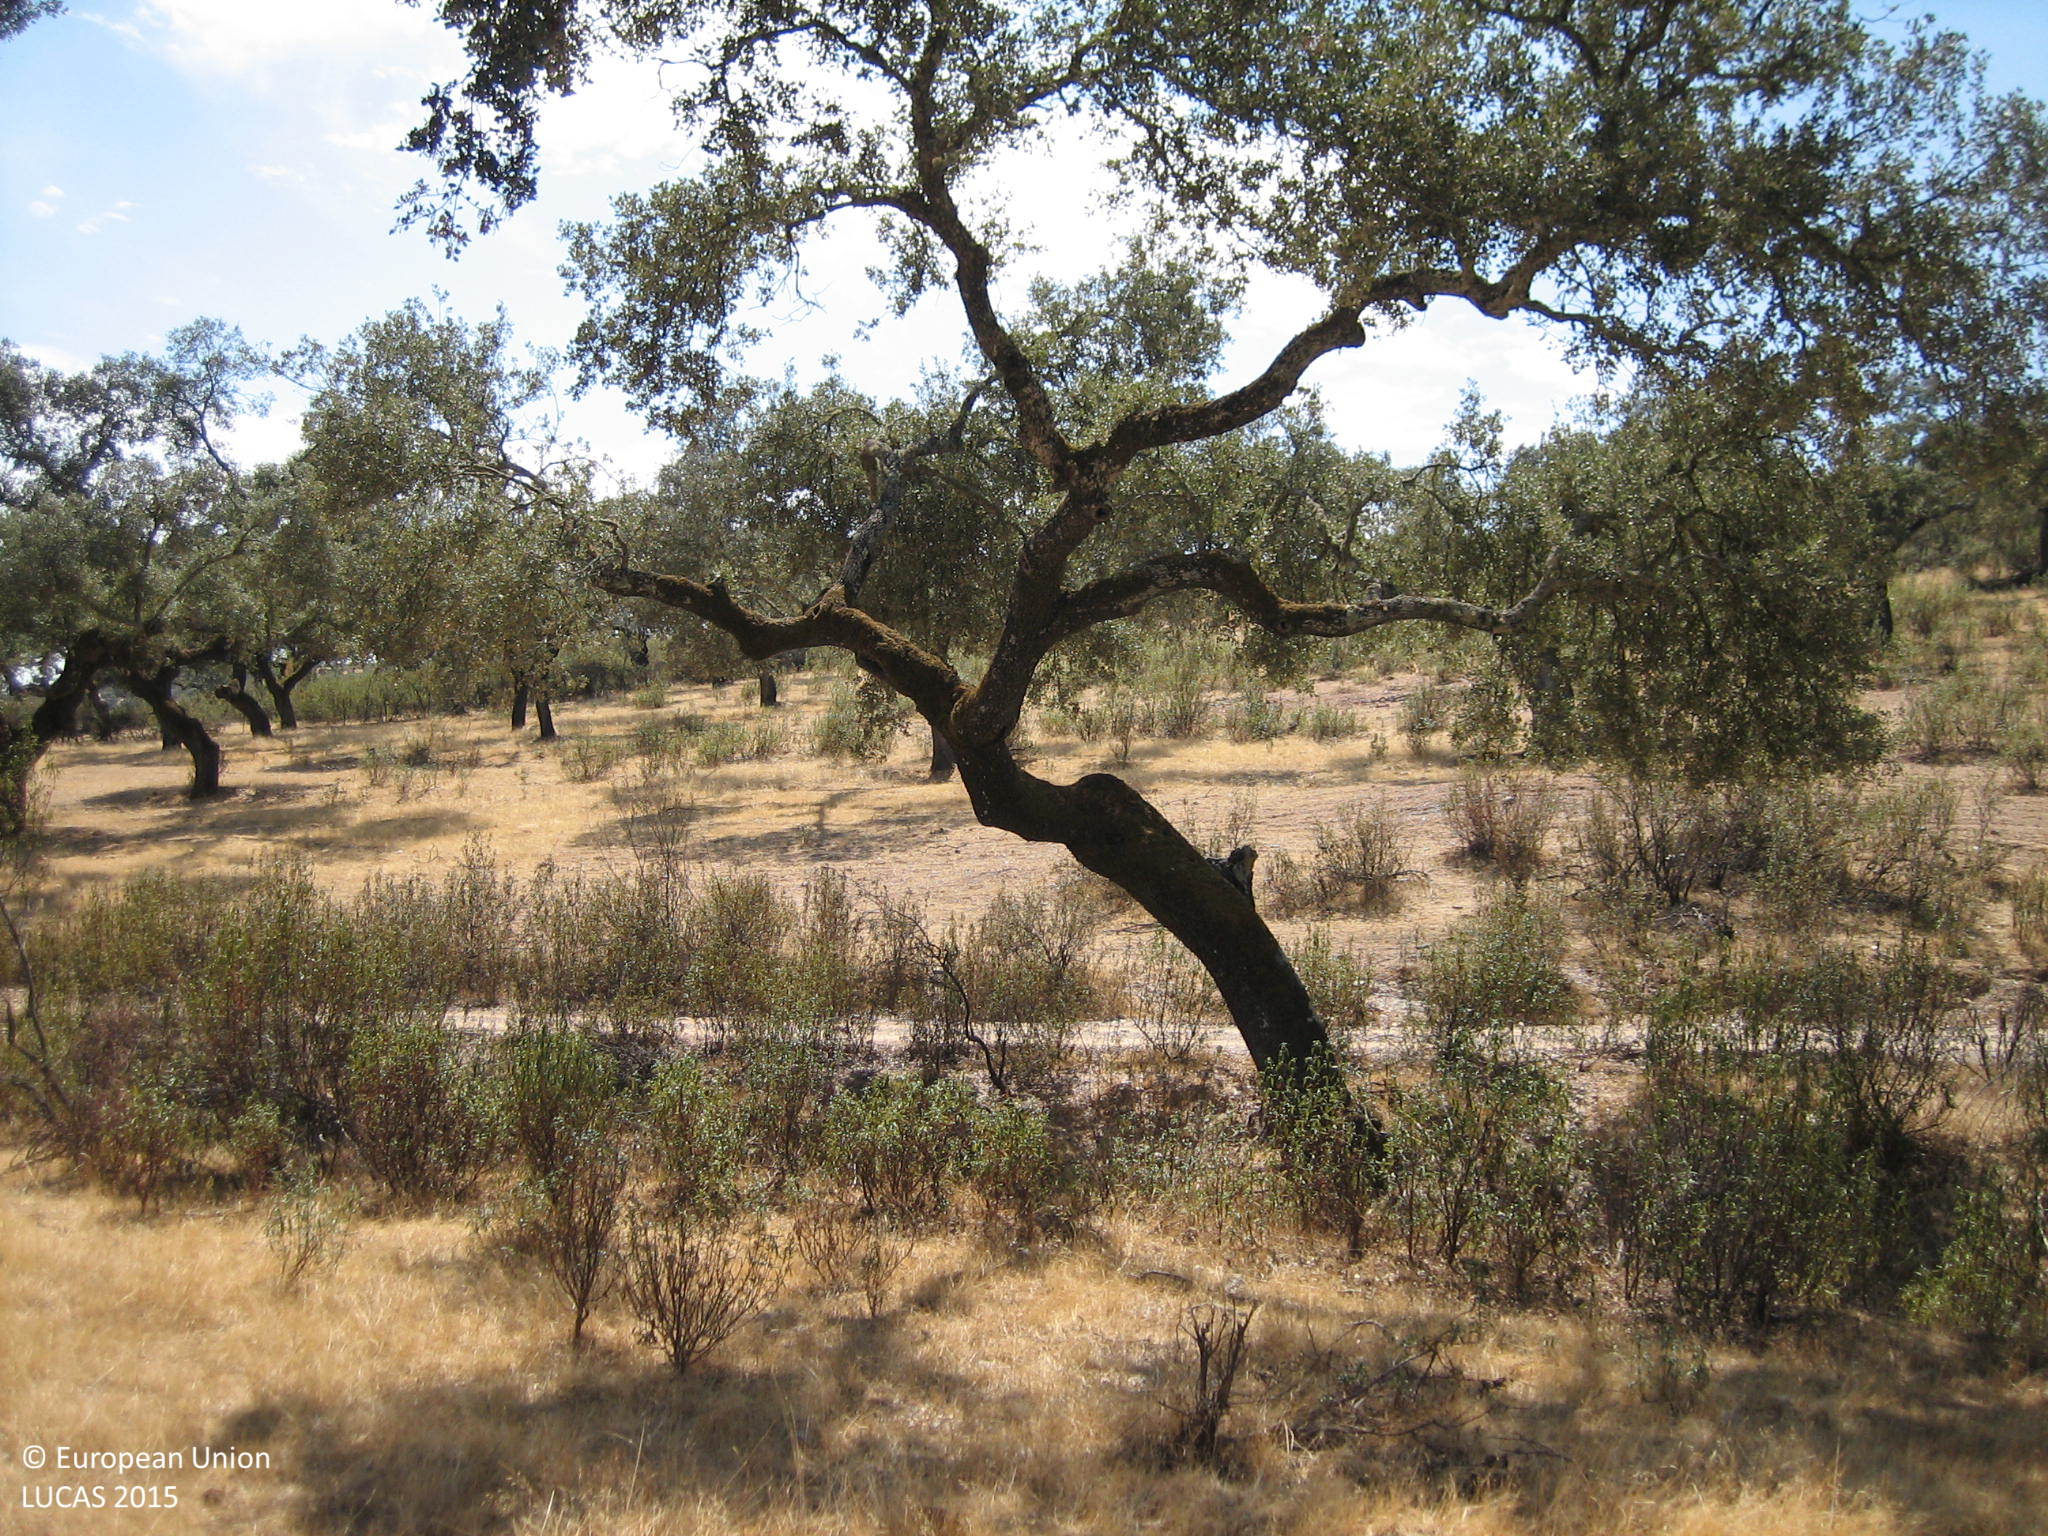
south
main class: Woodland
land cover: Broadleaved woodland
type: broadleaved evergreen forest
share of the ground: 10 - 25 %
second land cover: Grassland without tree/shrub cover
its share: 50 - 75 %
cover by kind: herbaceous plants 50 %, unconsolidated bare surface 25 %, broadleaved forest trees 20 %, shrubs 5 %
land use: Forestry
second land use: Agriculture (excluding fallow land and kitchen gardens)
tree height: > 5 m
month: September
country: ES
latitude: 38.2159
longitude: -7.1129
